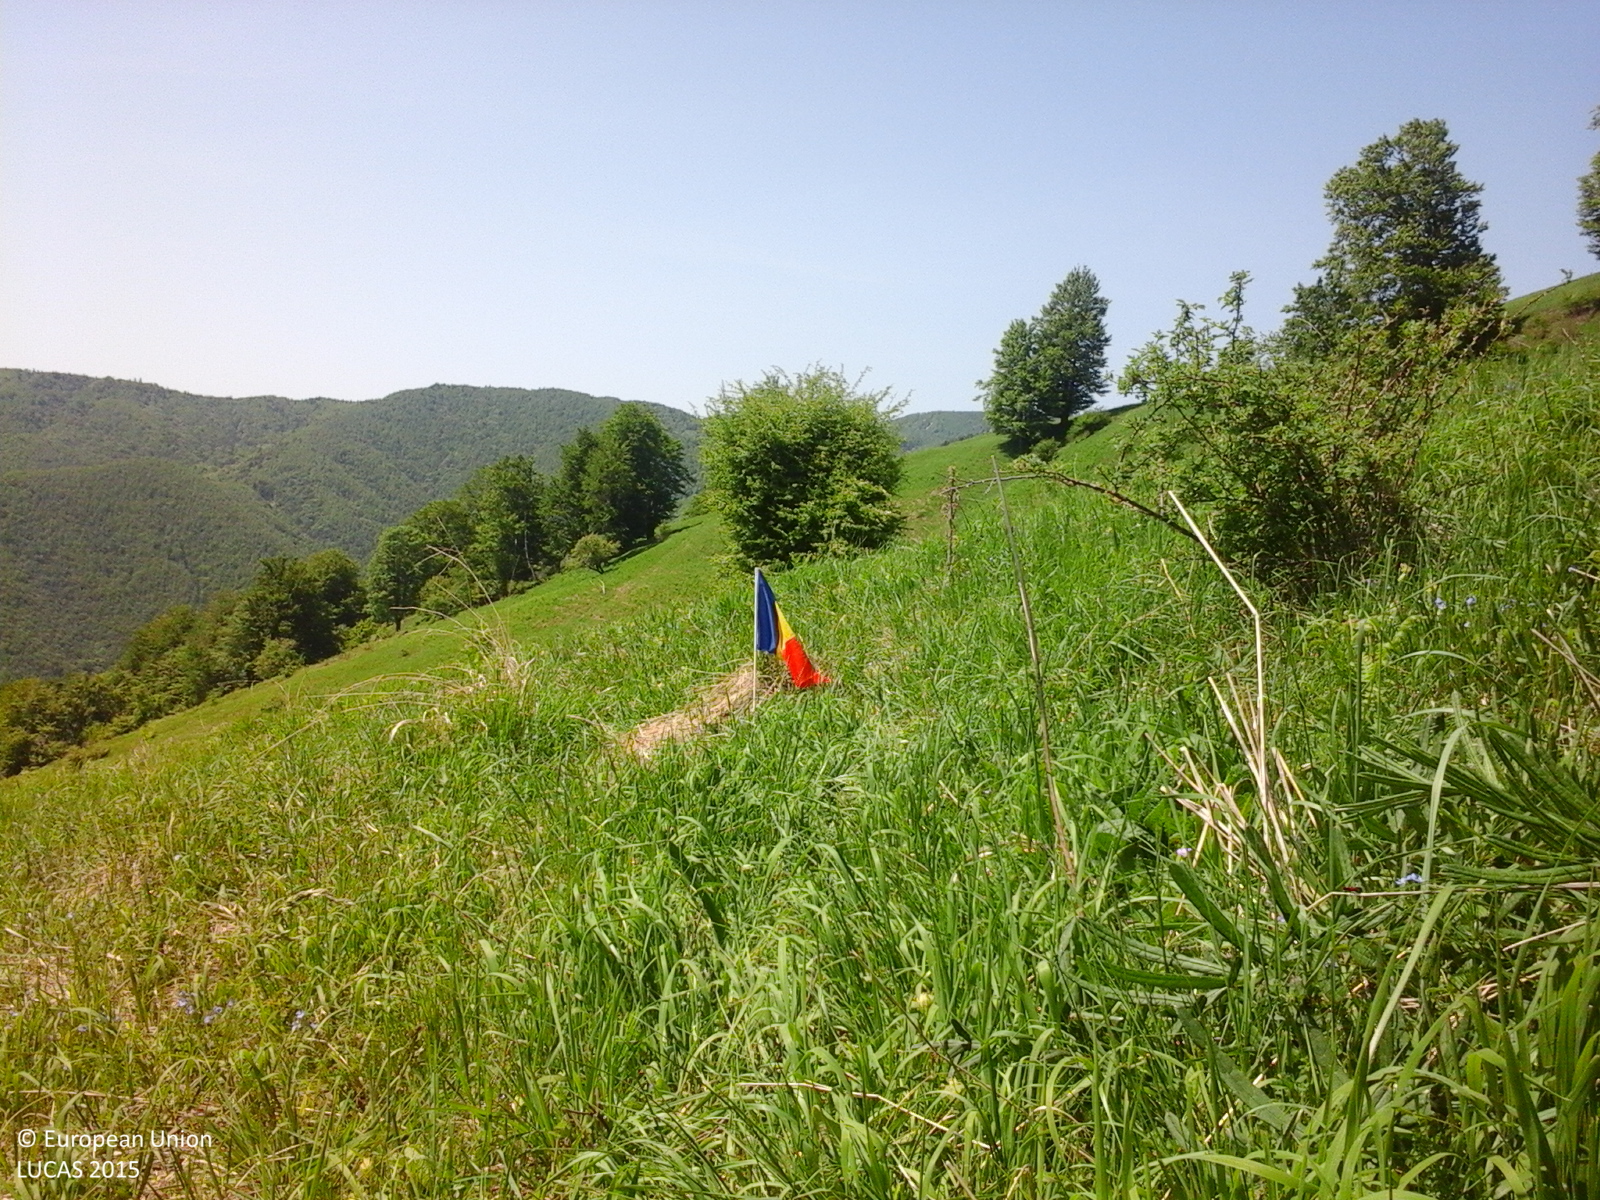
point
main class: Grassland
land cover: Grassland with sparse tree/shrub cover
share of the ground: > 75 %
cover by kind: herbaceous plants 85 %, shrubs 10 %, broadleaved forest trees 5 %
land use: Agriculture (excluding fallow land and kitchen gardens)
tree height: > 5 m
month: May
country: RO
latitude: 45.4306
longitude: 26.2361
